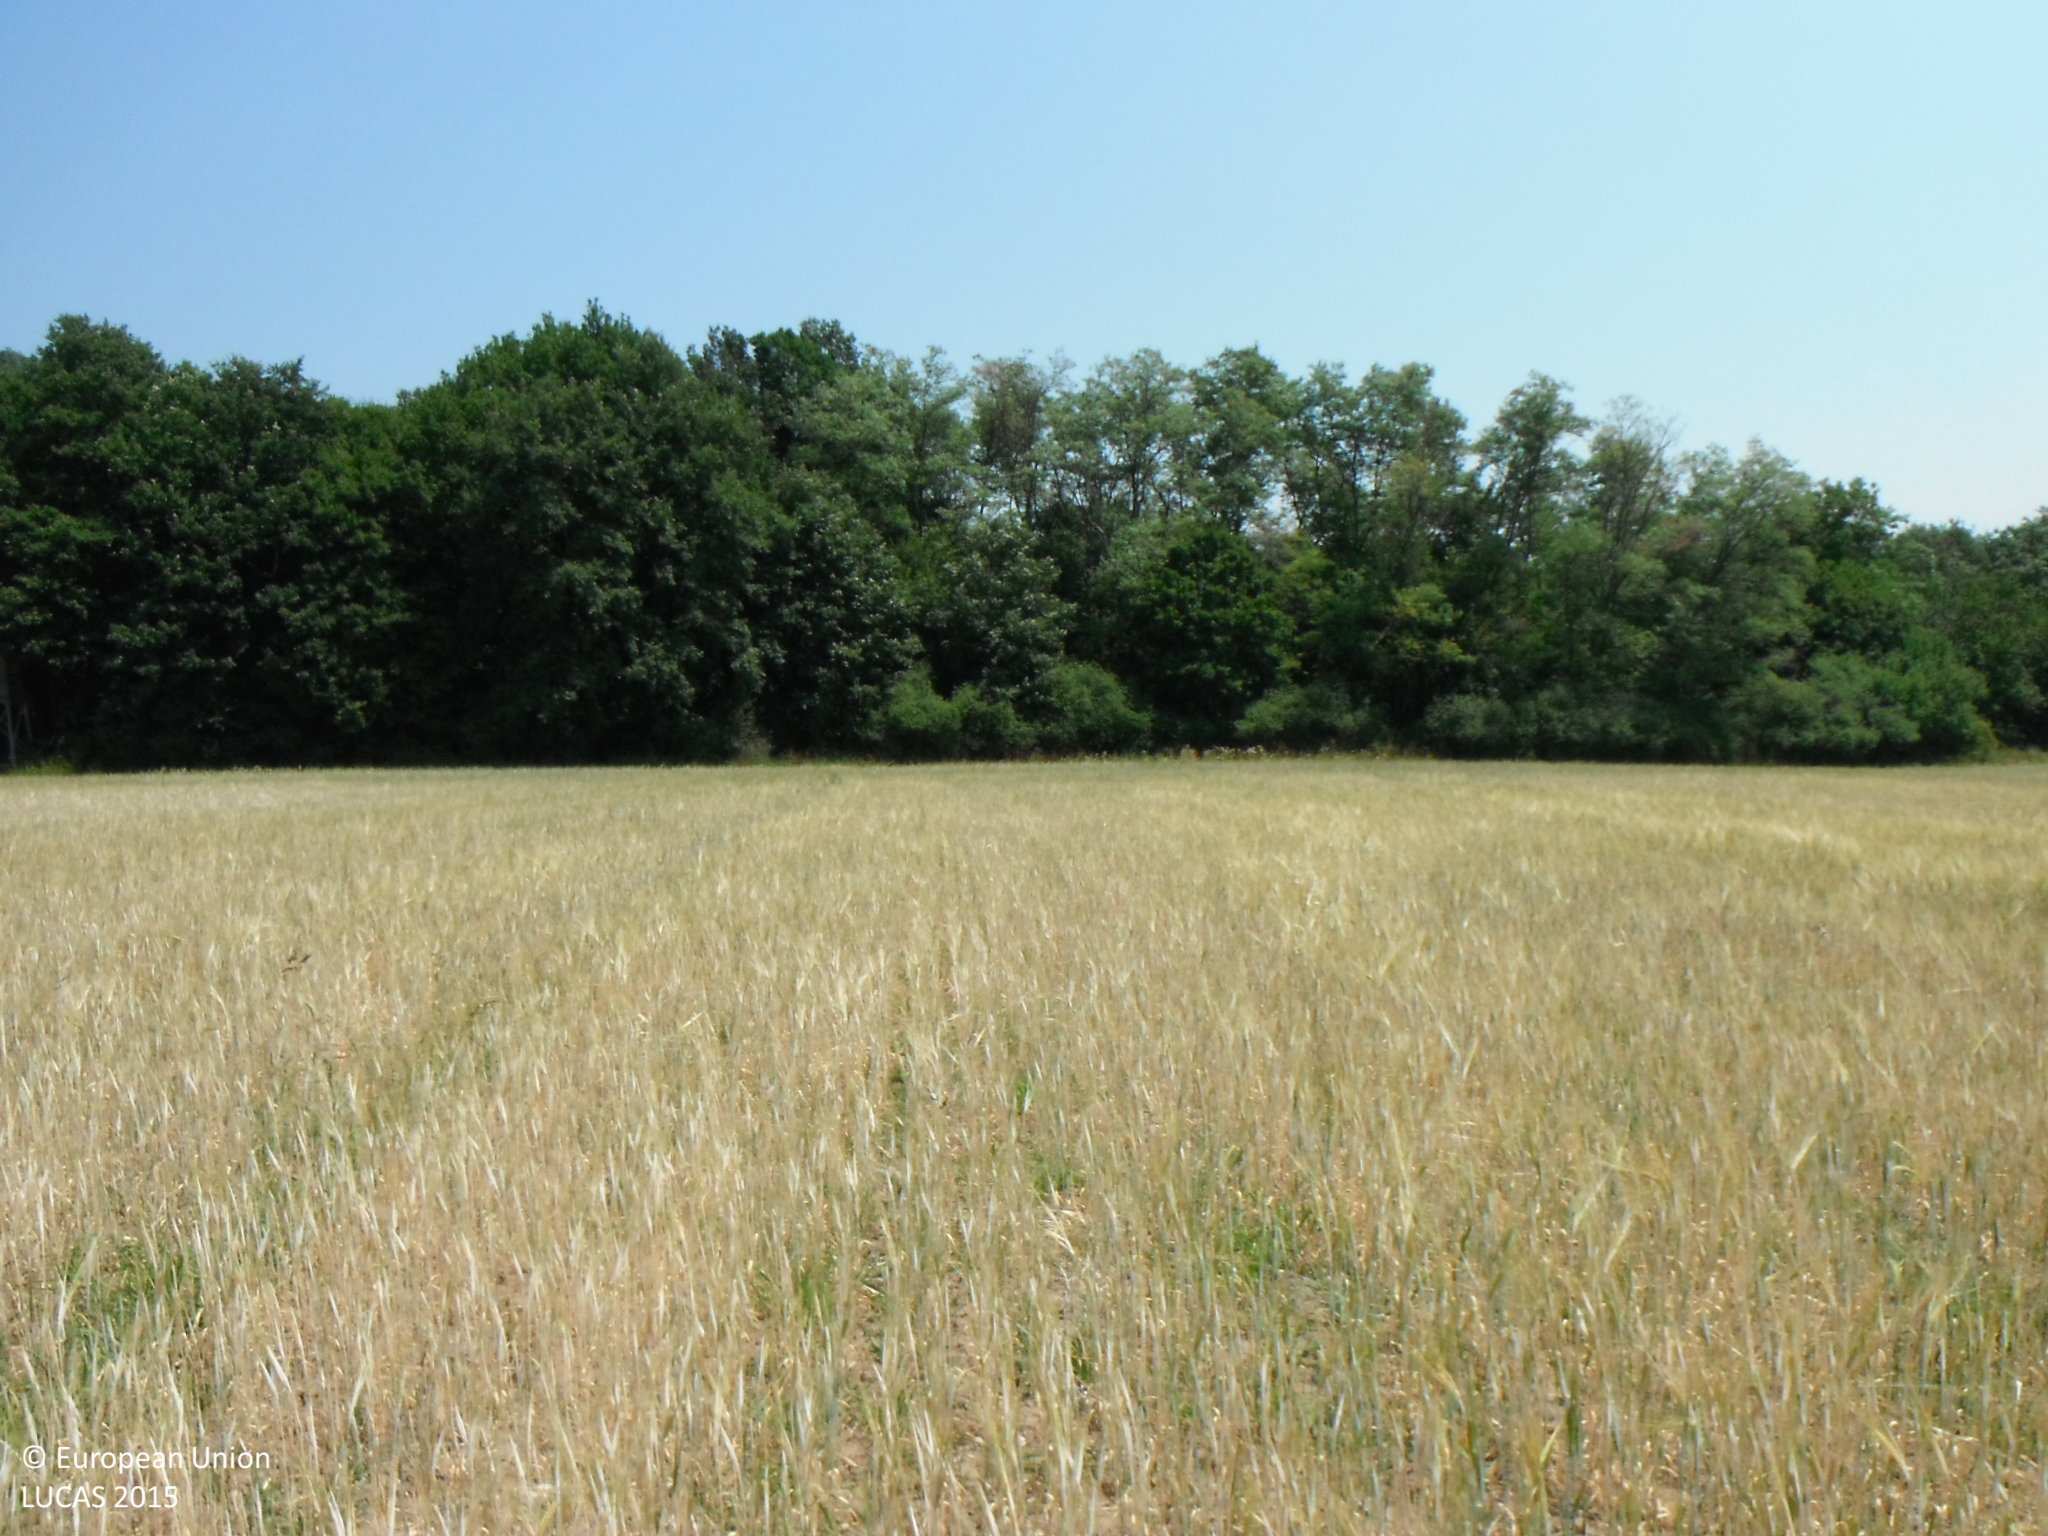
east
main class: Cropland
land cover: Barley
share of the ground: > 75 %
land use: Agriculture (excluding fallow land and kitchen gardens)
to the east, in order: Barley; Broadleaved woodland; Common wheat
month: July
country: SK
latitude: 48.1861
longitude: 19.1542
